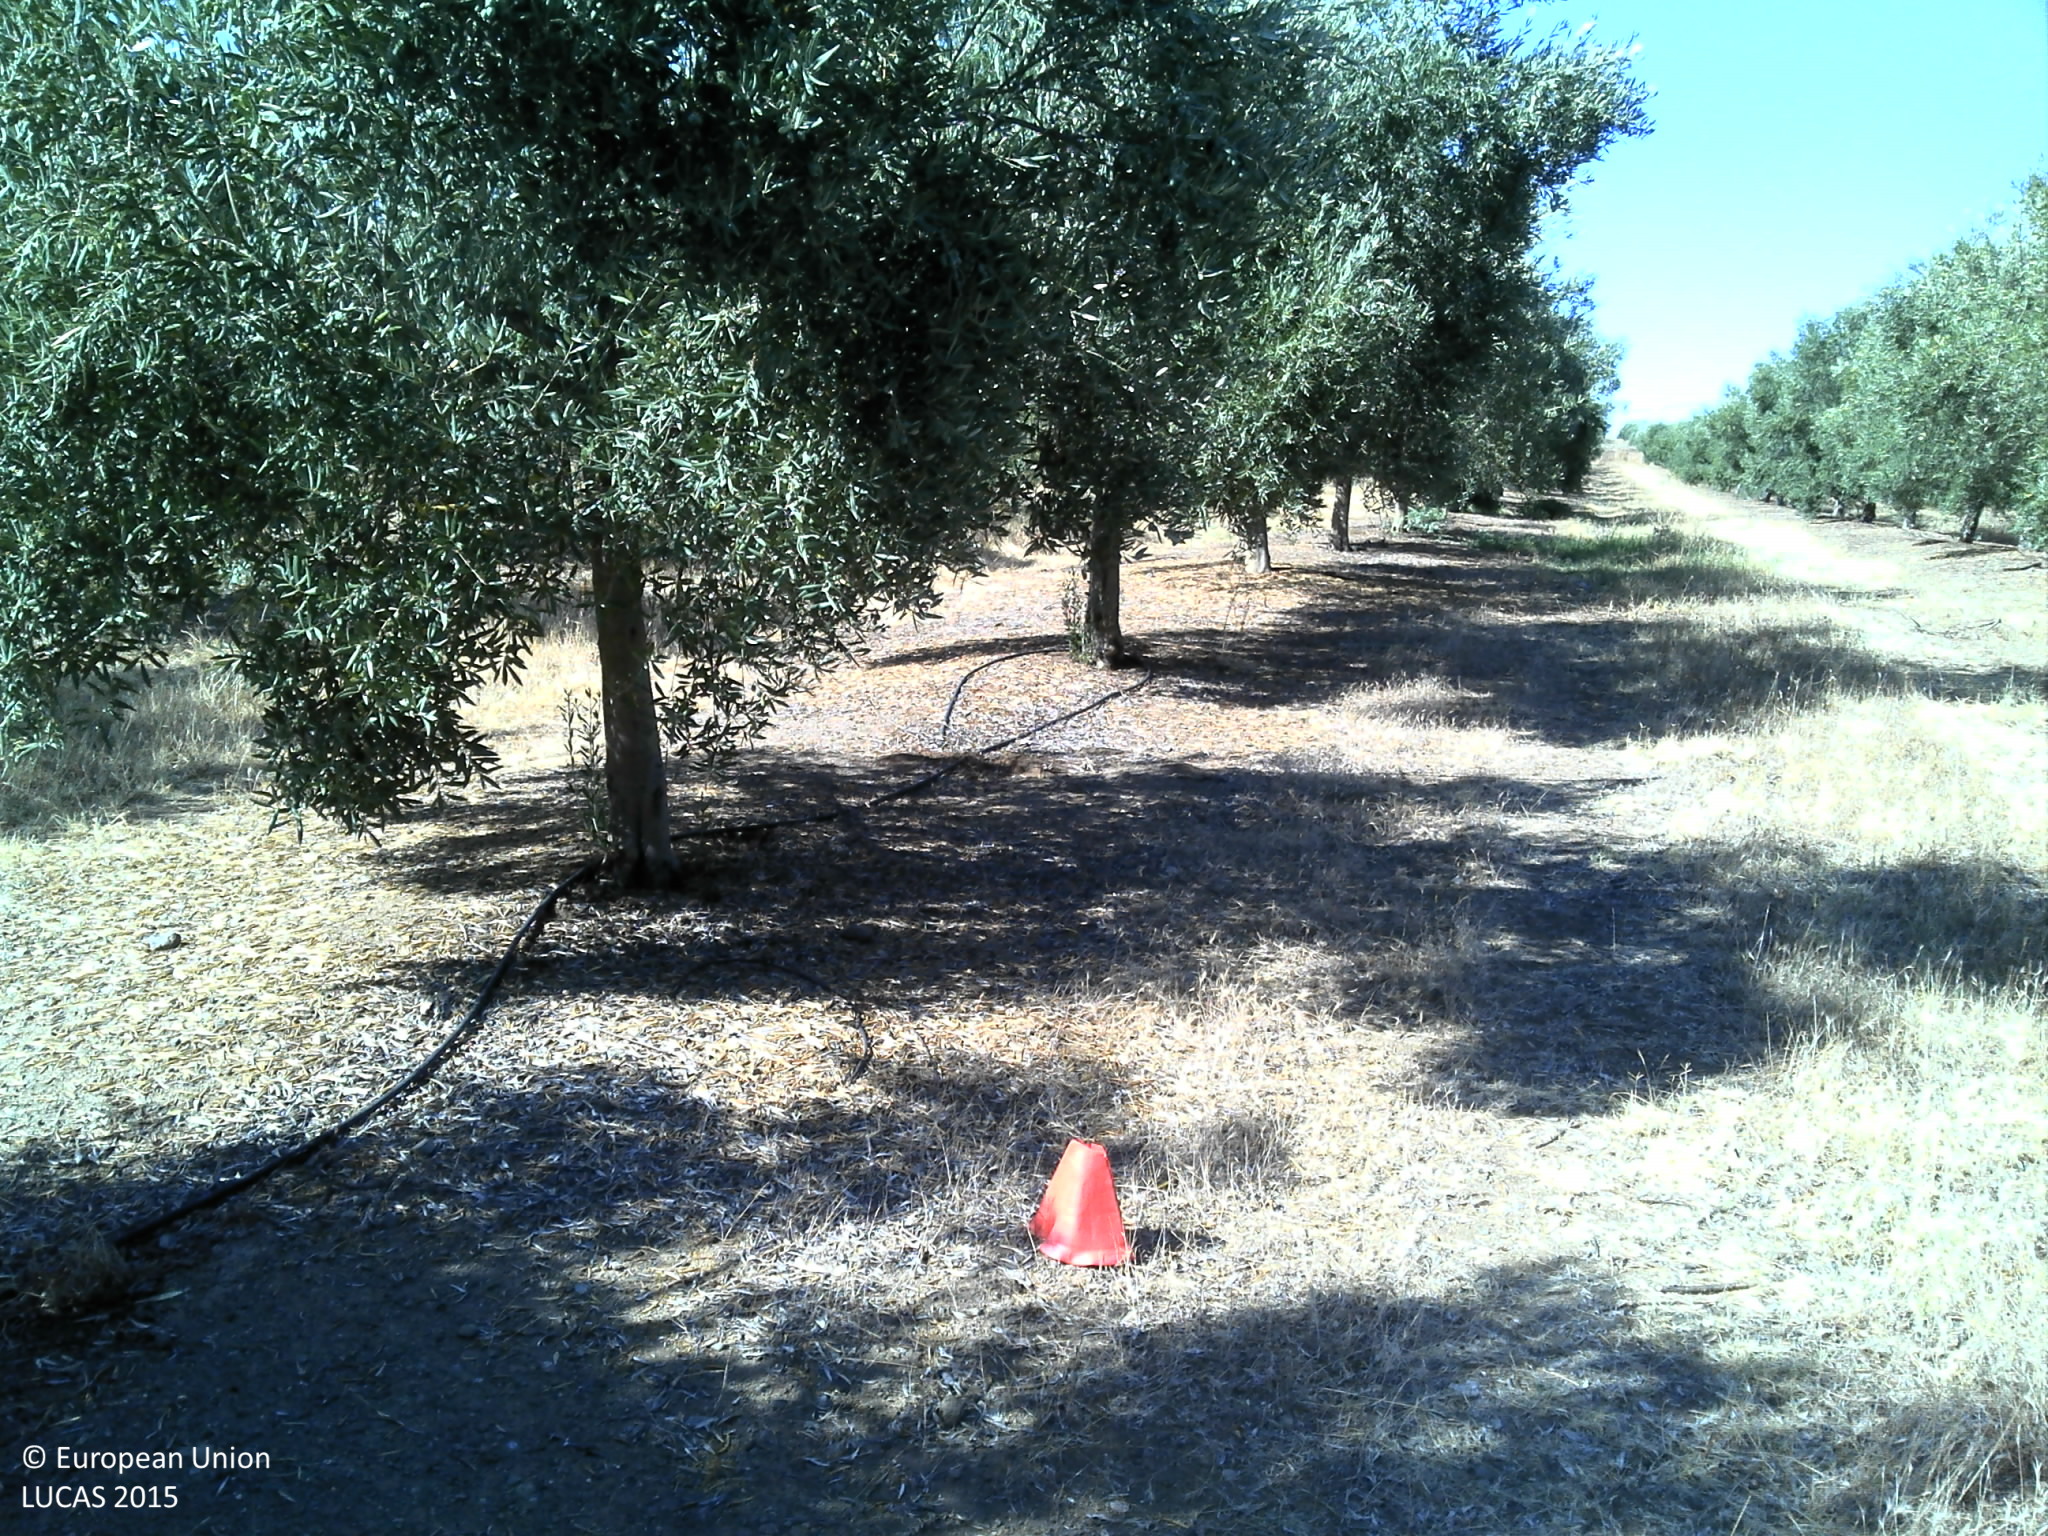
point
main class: Cropland
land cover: Olive groves
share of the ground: 50 - 75 %
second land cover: Grassland without tree/shrub cover
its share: 25 - 50 %
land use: Agriculture (excluding fallow land and kitchen gardens)
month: July
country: PT
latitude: 37.9776
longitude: -7.7034
